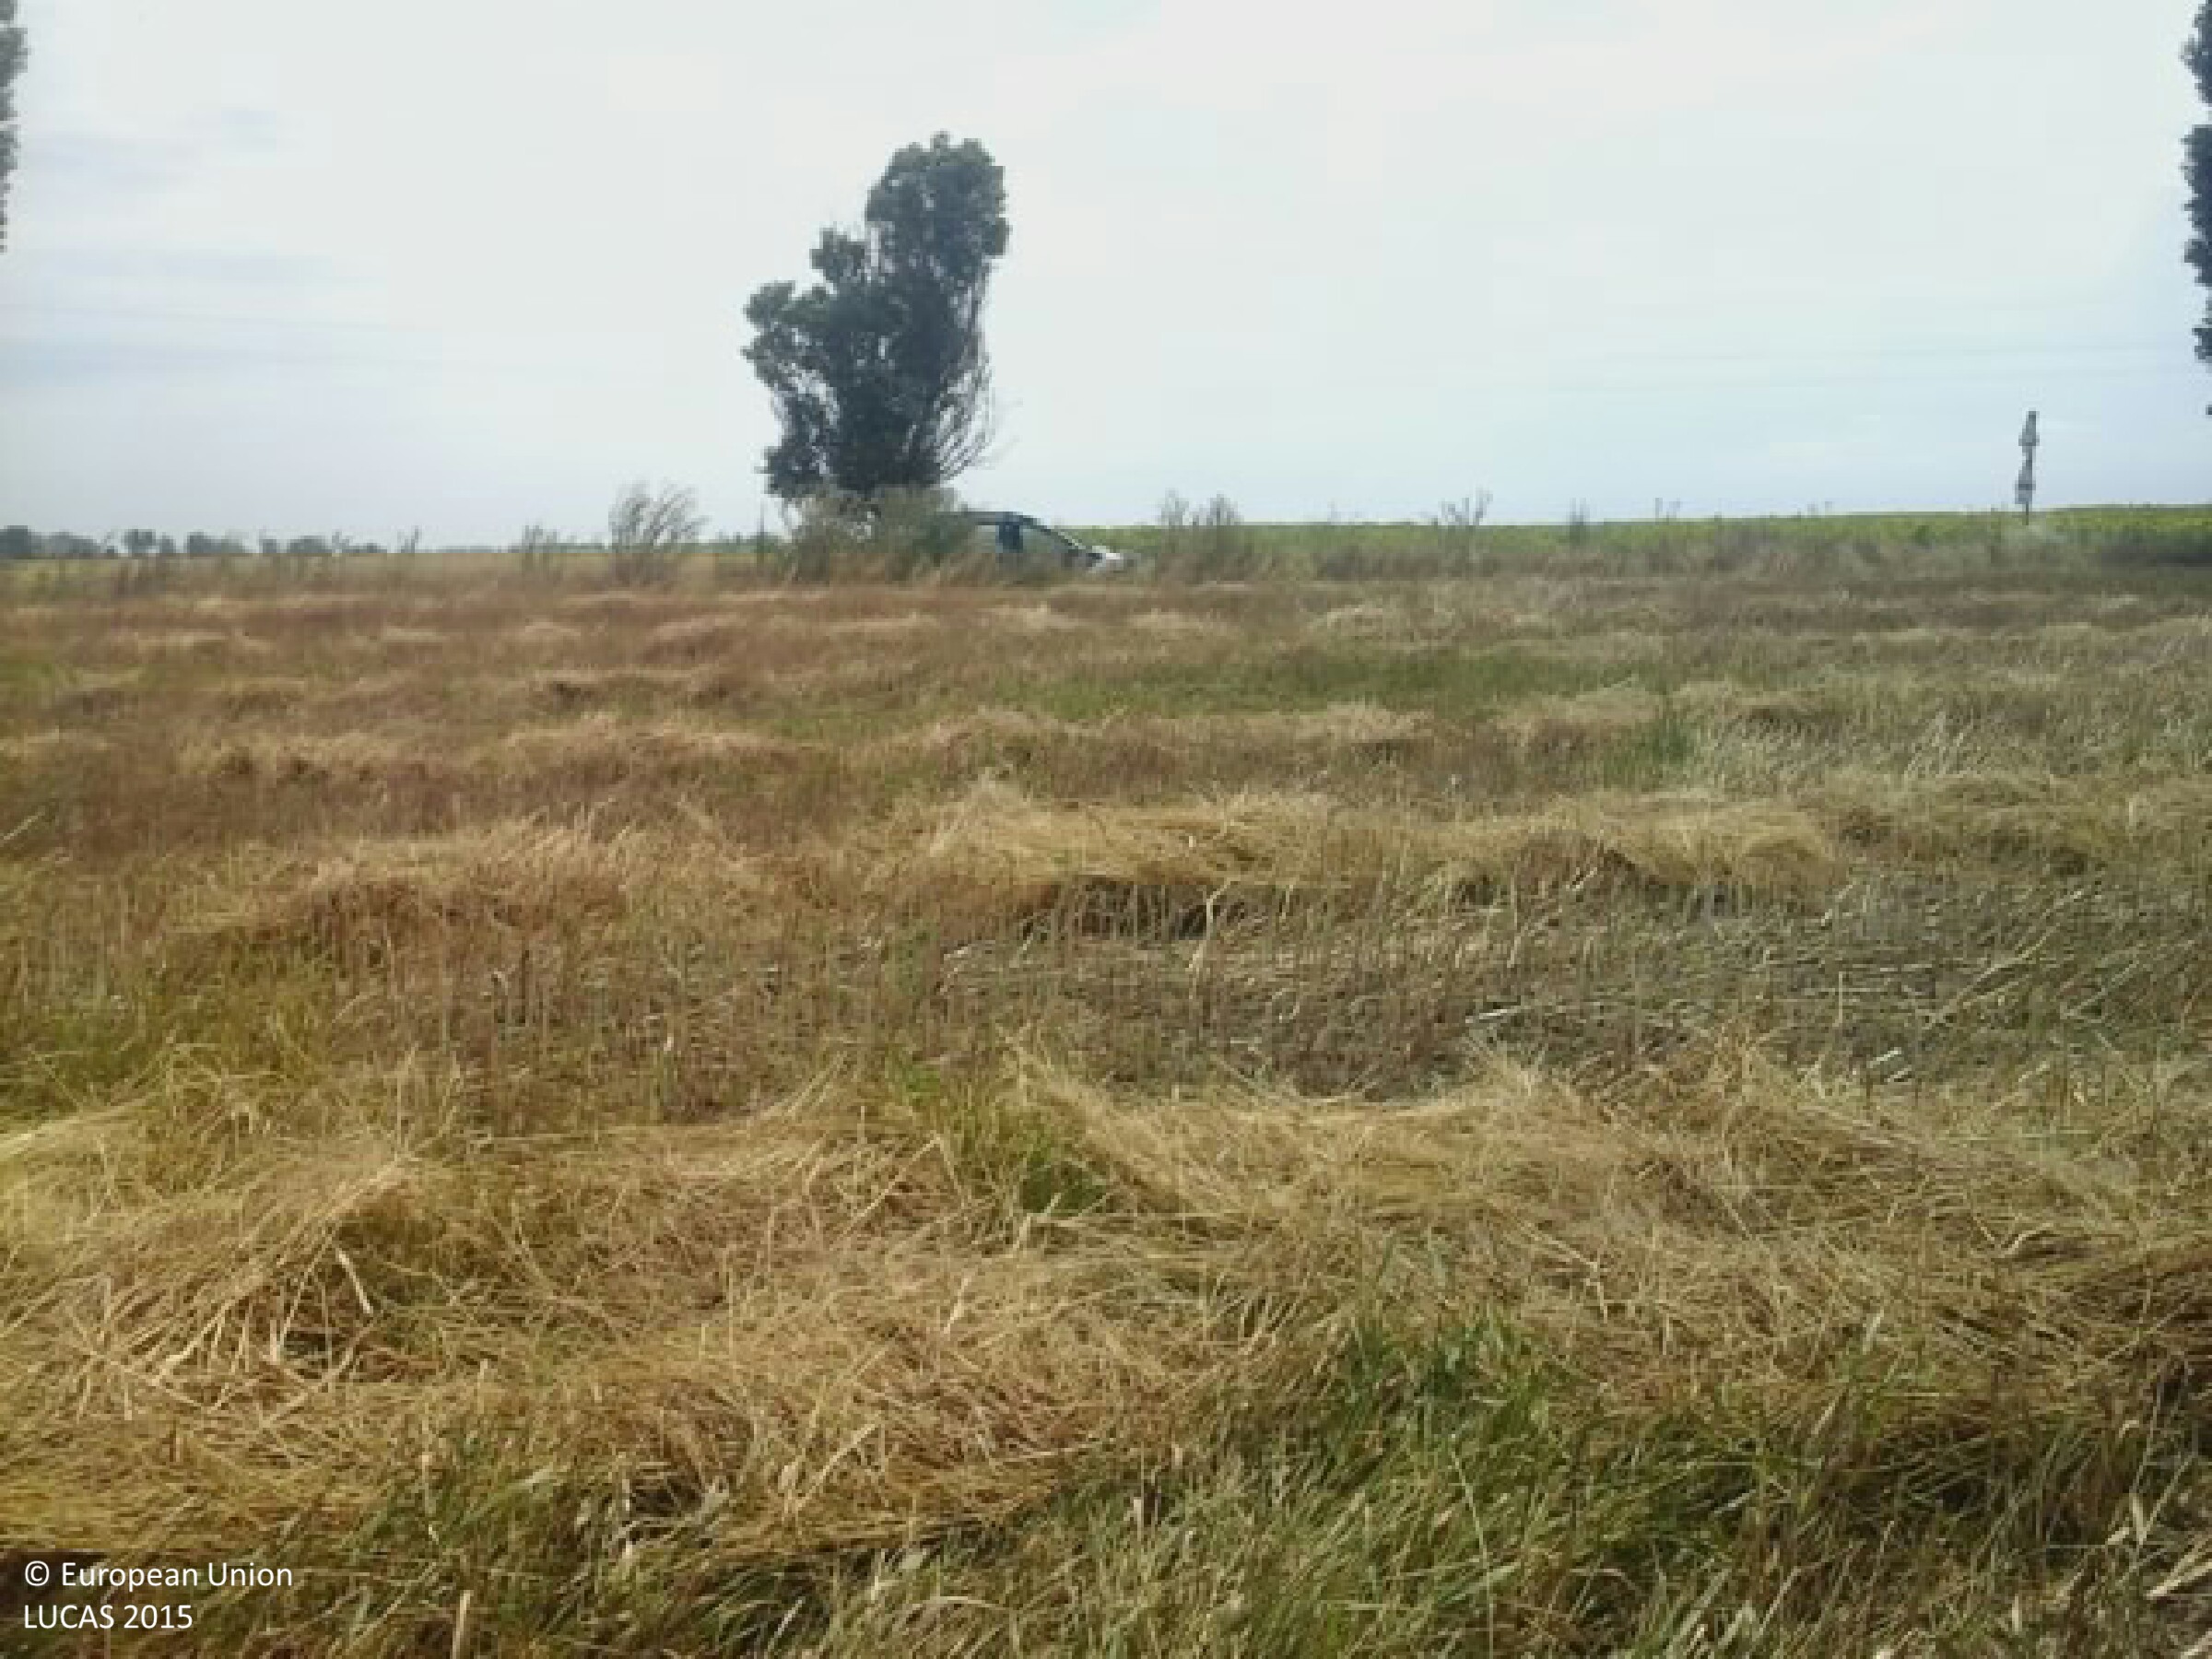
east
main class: Cropland
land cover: Rape and turnip rape
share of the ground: 25 - 50 %
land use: Agriculture (excluding fallow land and kitchen gardens)
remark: Harvested field
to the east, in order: Rape and turnip rape; Lines of trees; Grass margins; Paved roads, cycling and walking lanes; Ditches and canals; Grass margins; Common wheat; Electric lines; Common wheat
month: July
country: HU
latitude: 47.1489
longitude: 18.9970
